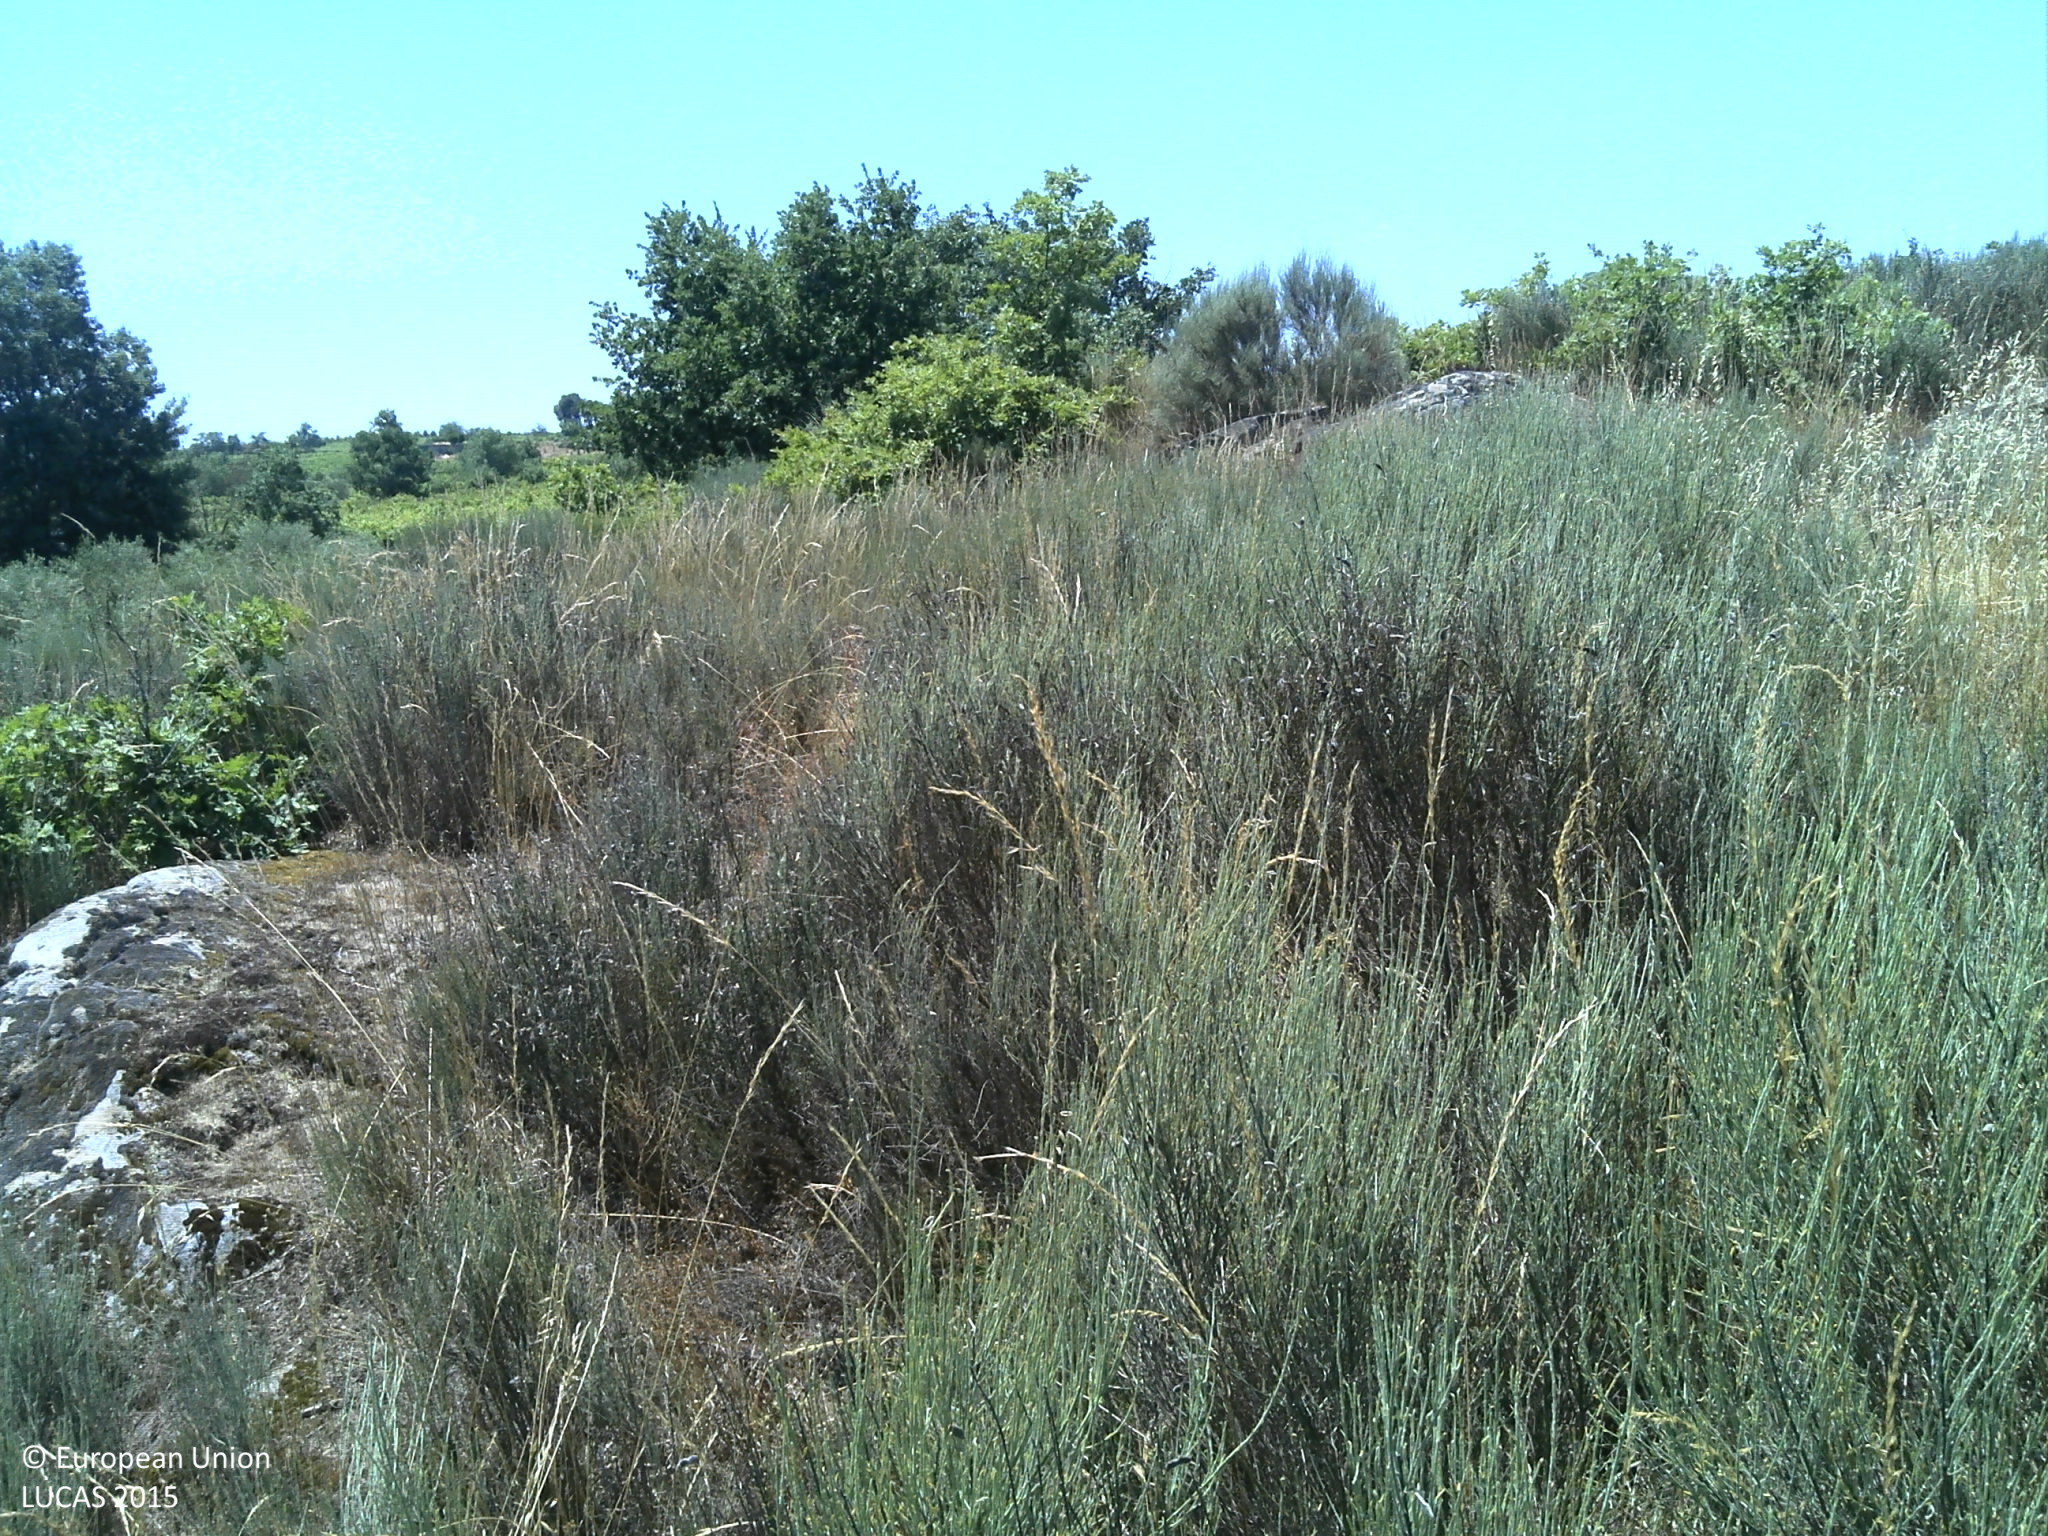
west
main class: Shrubland
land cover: Shrubland without tree cover
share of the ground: 50 - 75 %
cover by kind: shrubs 50 %, consolidated bare surface 30 %, herbaceous plants 10 %, unconsolidated bare surface 10 %
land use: Abandoned areas
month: June
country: PT
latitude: 40.7719
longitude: -7.1559
